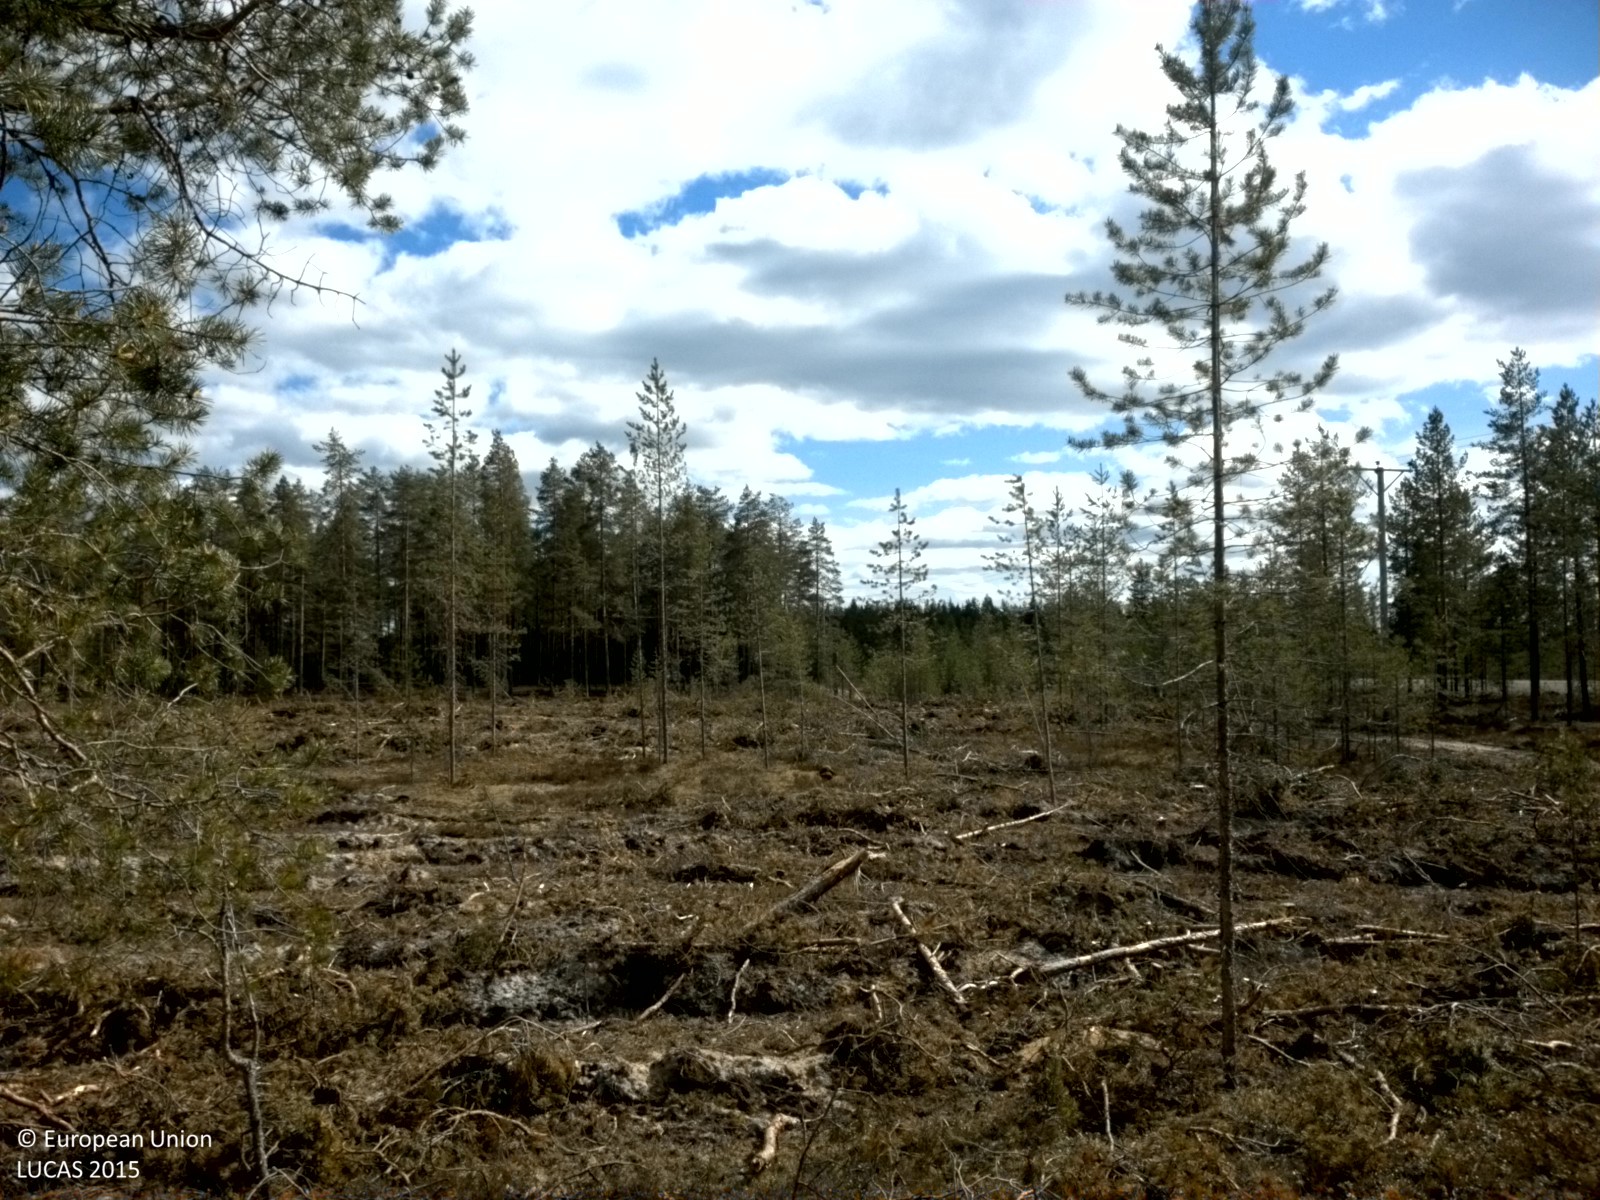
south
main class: Shrubland
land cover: Shrubland with sparse tree cover
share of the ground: 50 - 75 %
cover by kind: shrubs 65 %, unconsolidated bare surface 20 %, lichens and mosses 10 %, coniferous forest trees 5 %
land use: Forestry
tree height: > 5 m
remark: Clear cut
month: June
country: SE
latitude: 63.9643
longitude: 20.1284
